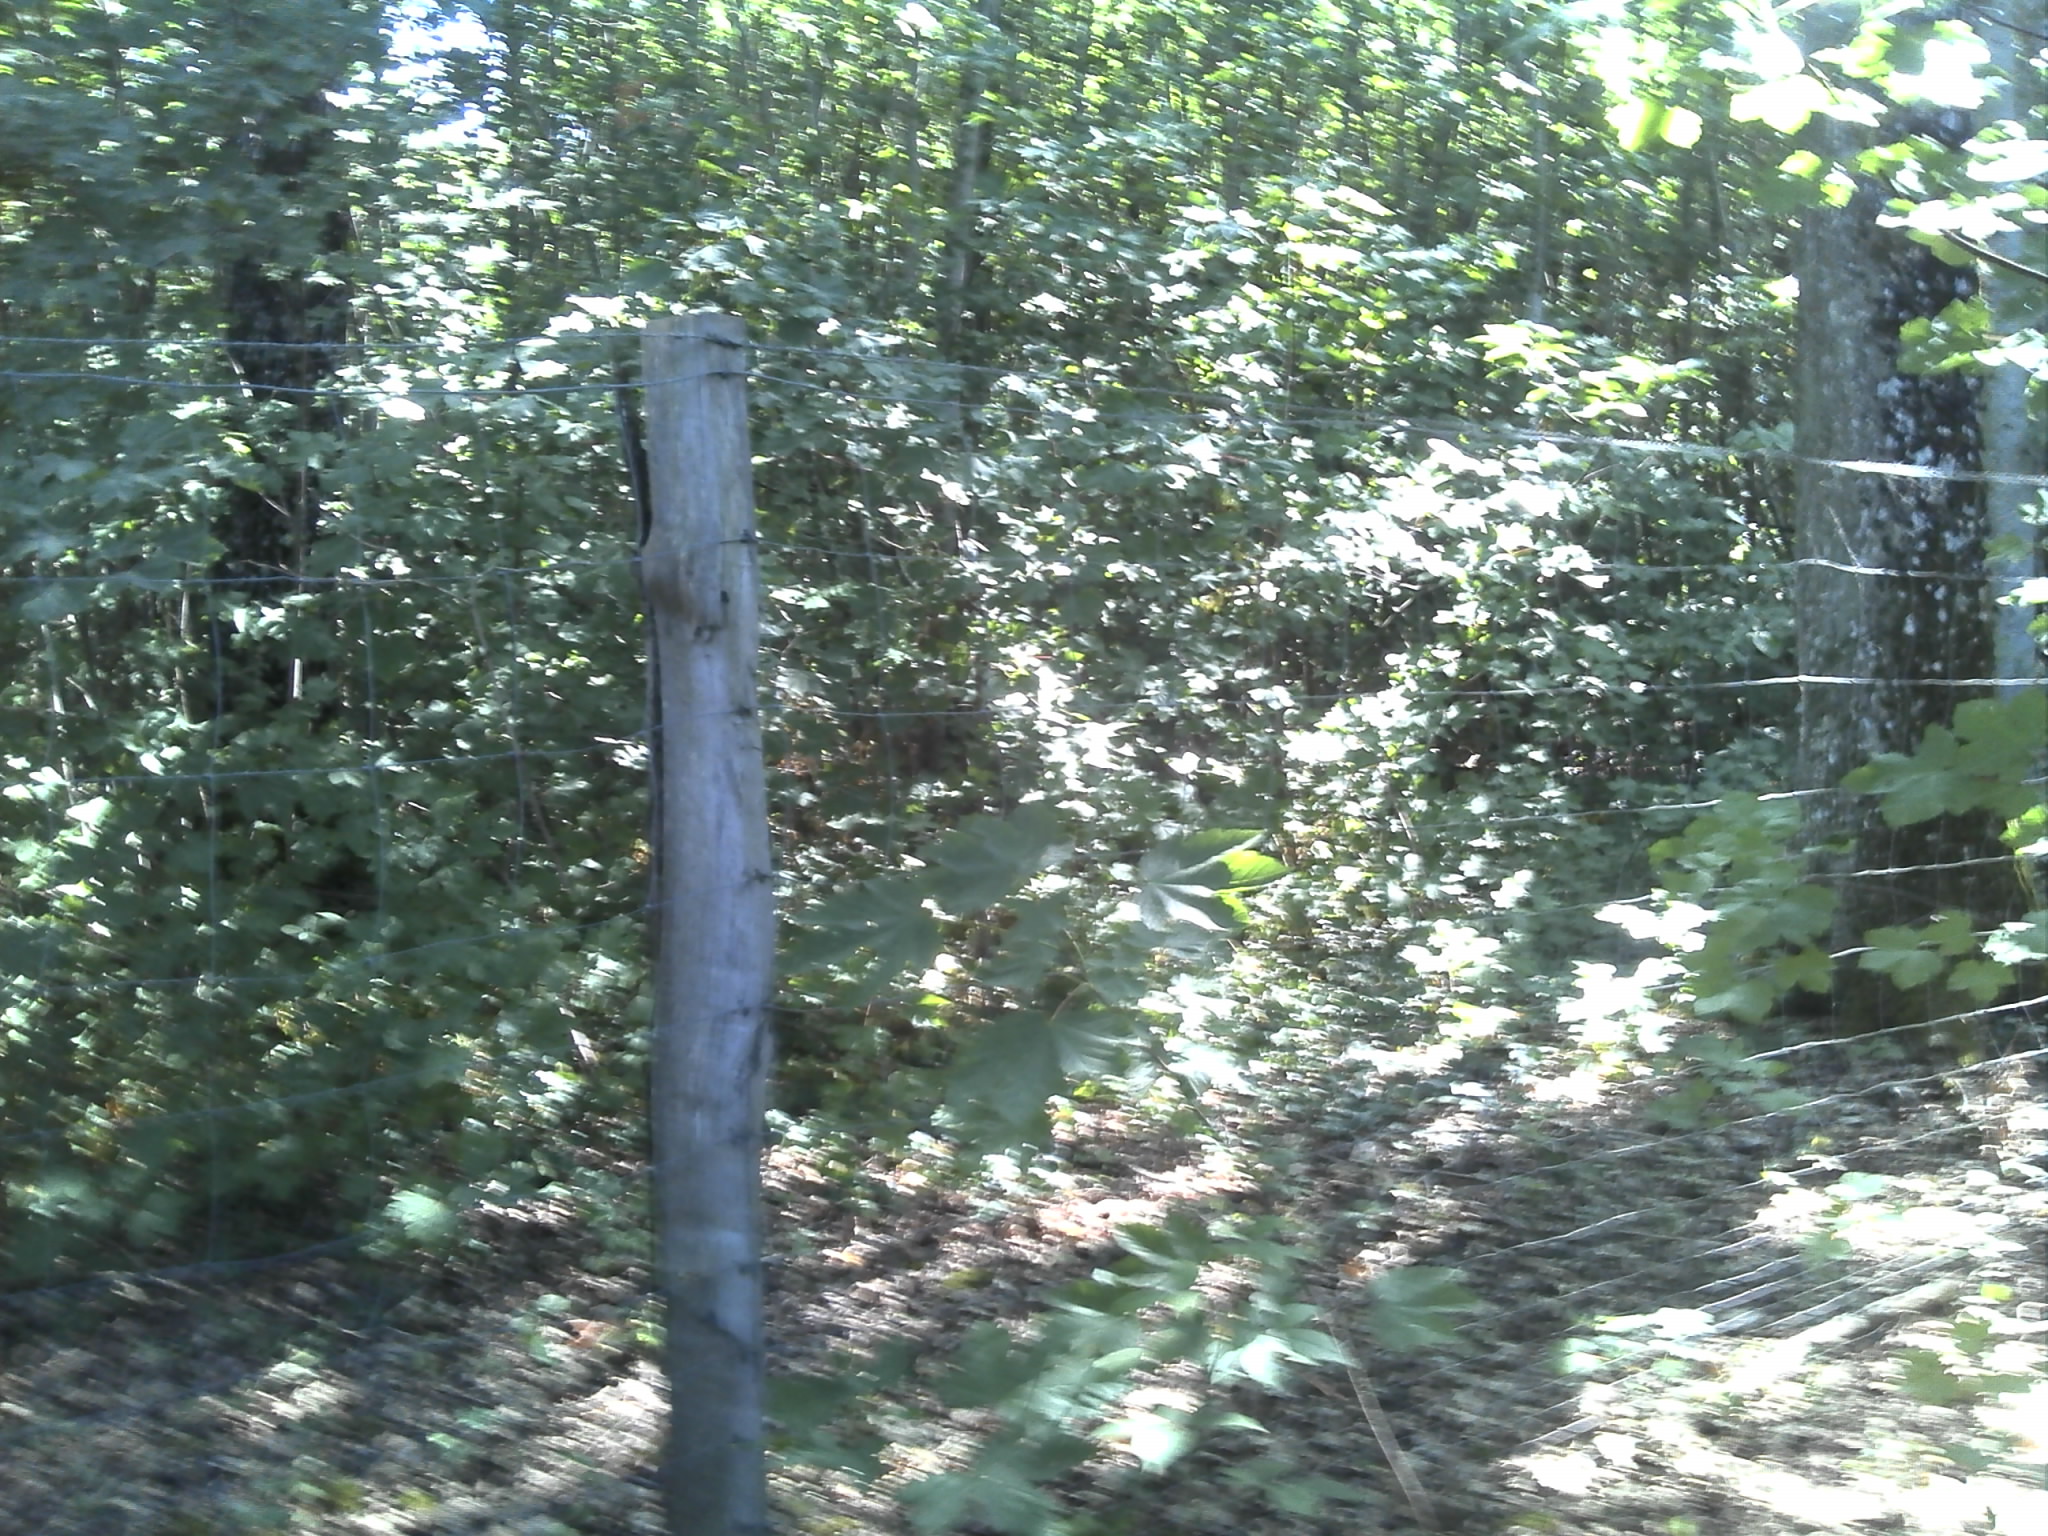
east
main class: Woodland
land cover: Broadleaved woodland
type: mesophytic deciduous forest
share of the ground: > 75 %
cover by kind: broadleaved forest trees 90 %, shrubs 5 %, herbaceous plants 5 %
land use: Forestry
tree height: > 5 m
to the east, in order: Broadleaved woodland; Fences; Broadleaved woodland
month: July
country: FR
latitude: 47.0166
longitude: 1.6086
